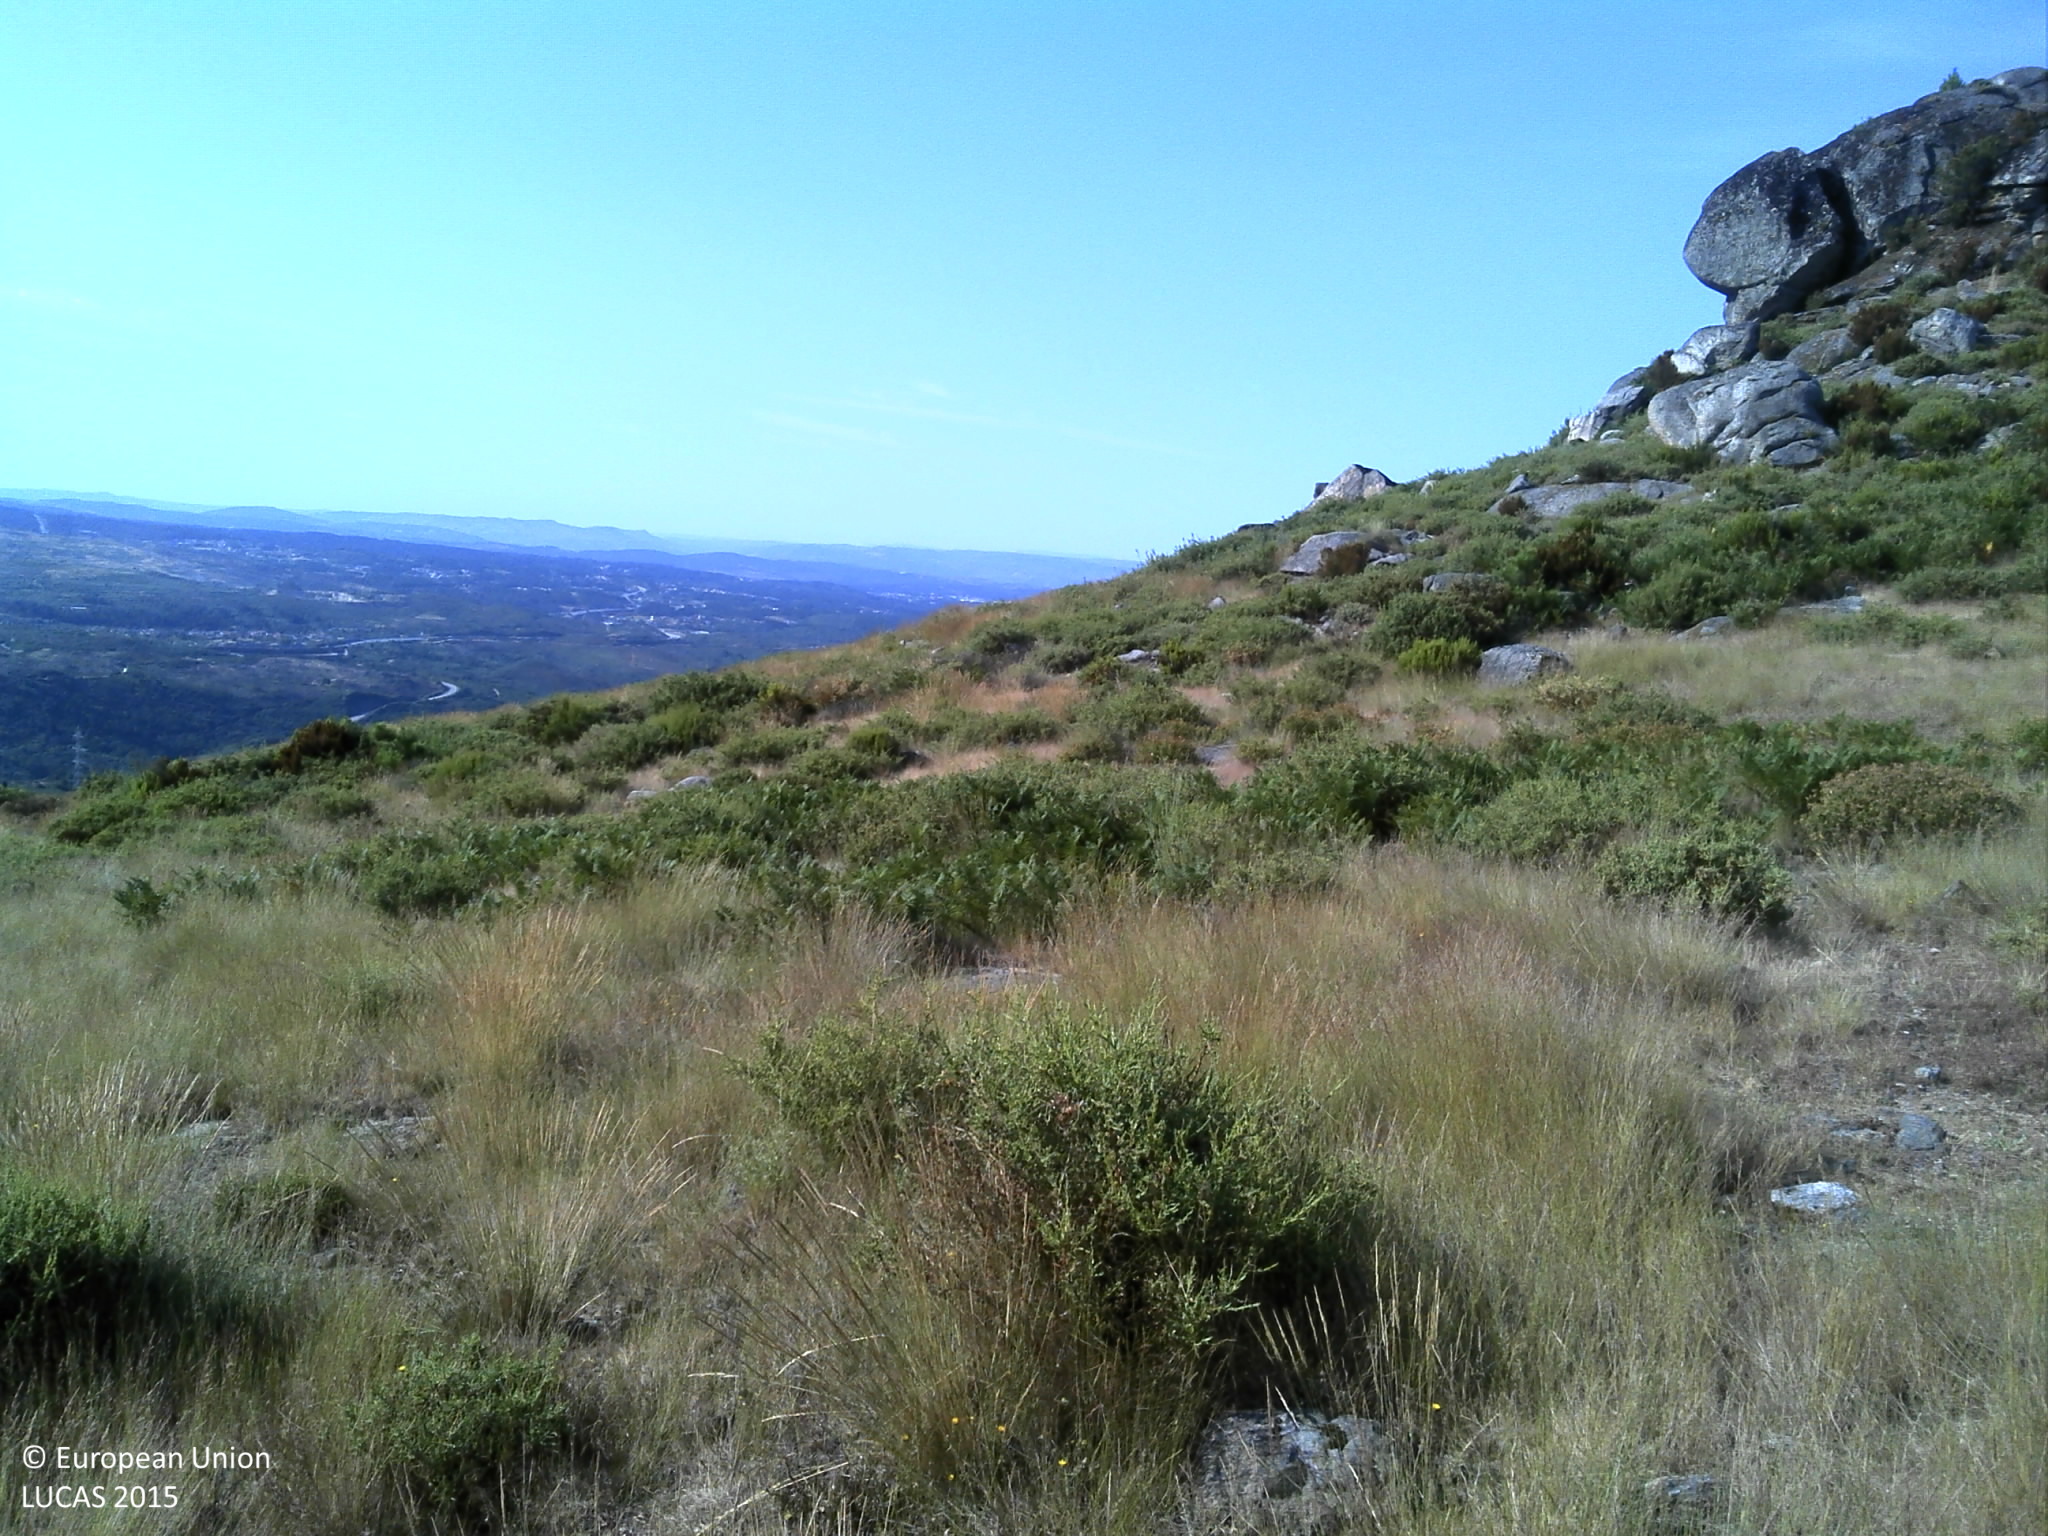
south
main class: Shrubland
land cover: Shrubland without tree cover
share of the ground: 50 - 75 %
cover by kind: shrubs 75 %, herbaceous plants 10 %, unconsolidated bare surface 10 %, consolidated bare surface 5 %
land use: Agriculture (excluding fallow land and kitchen gardens)
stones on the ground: 10 - 25 %
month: July
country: PT
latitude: 41.3898
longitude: -7.7234
